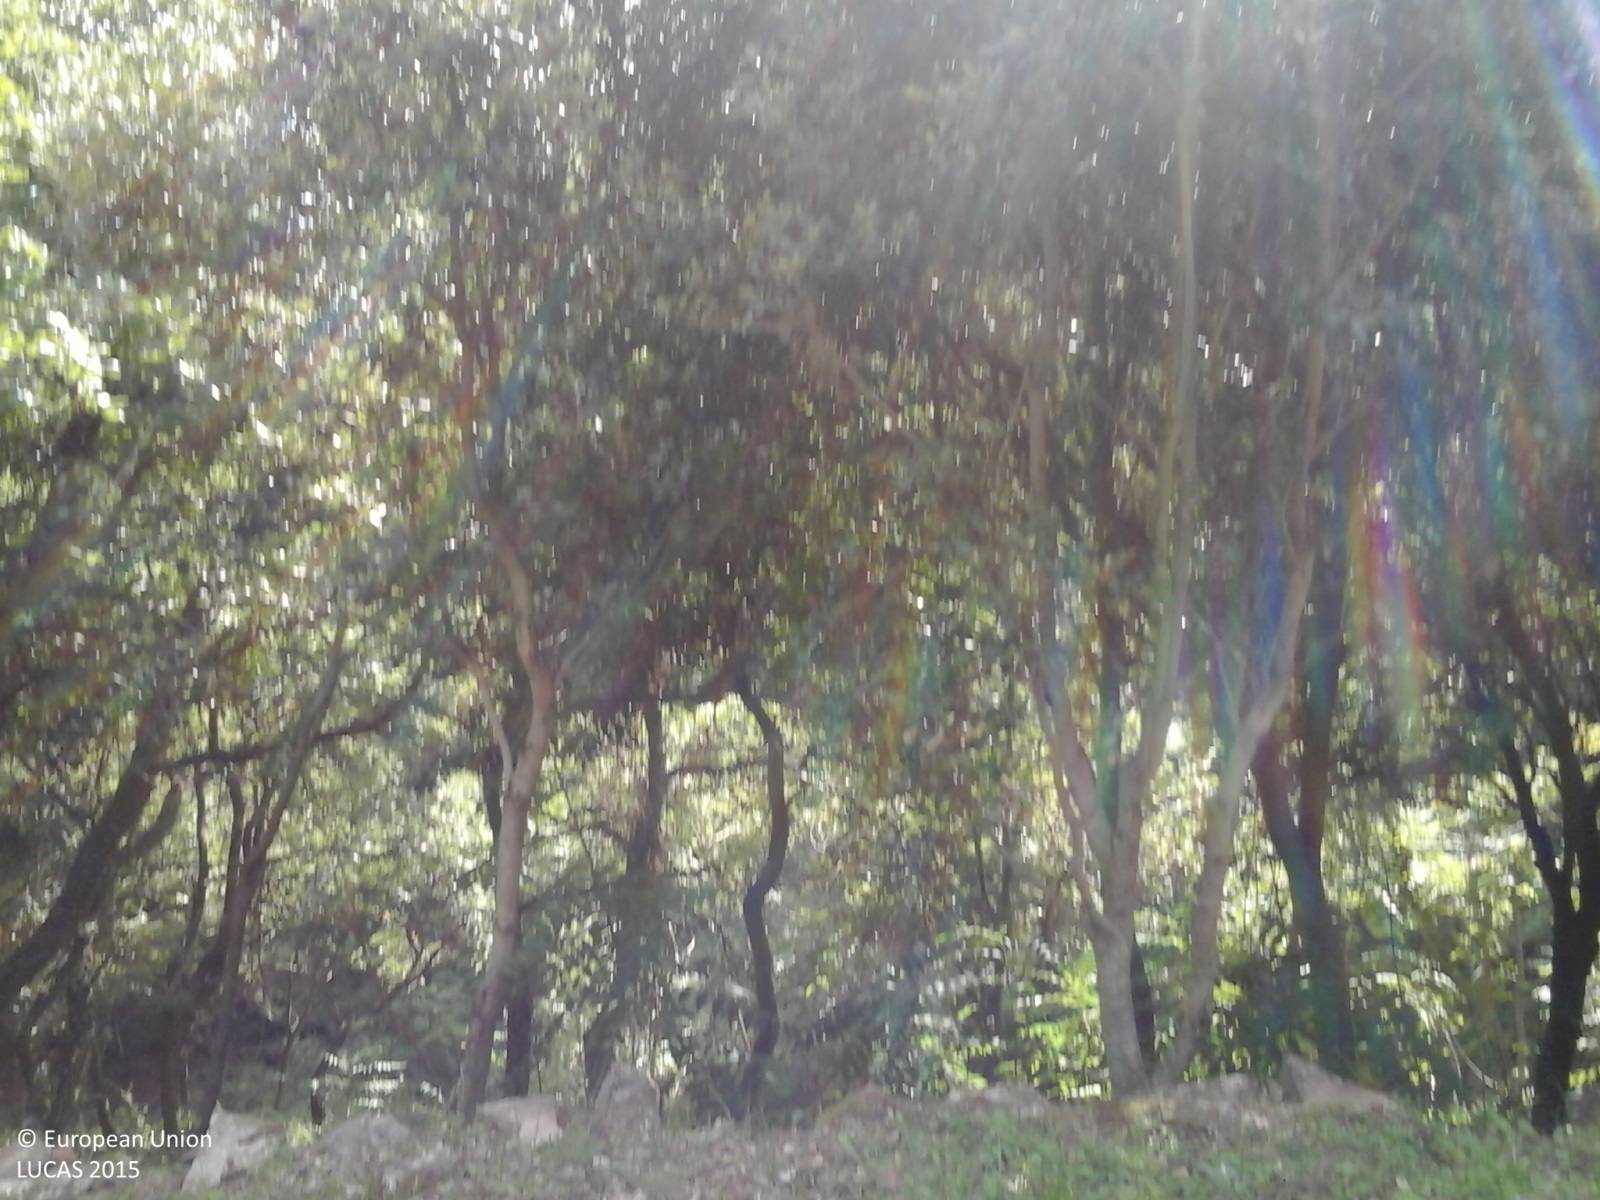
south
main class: Woodland
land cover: Broadleaved woodland
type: broadleaved evergreen forest
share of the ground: > 75 %
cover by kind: broadleaved forest trees 100 %
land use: Semi-natural and natural areas not in use
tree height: > 5 m
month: October
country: IT
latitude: 40.4001
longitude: 8.4643
